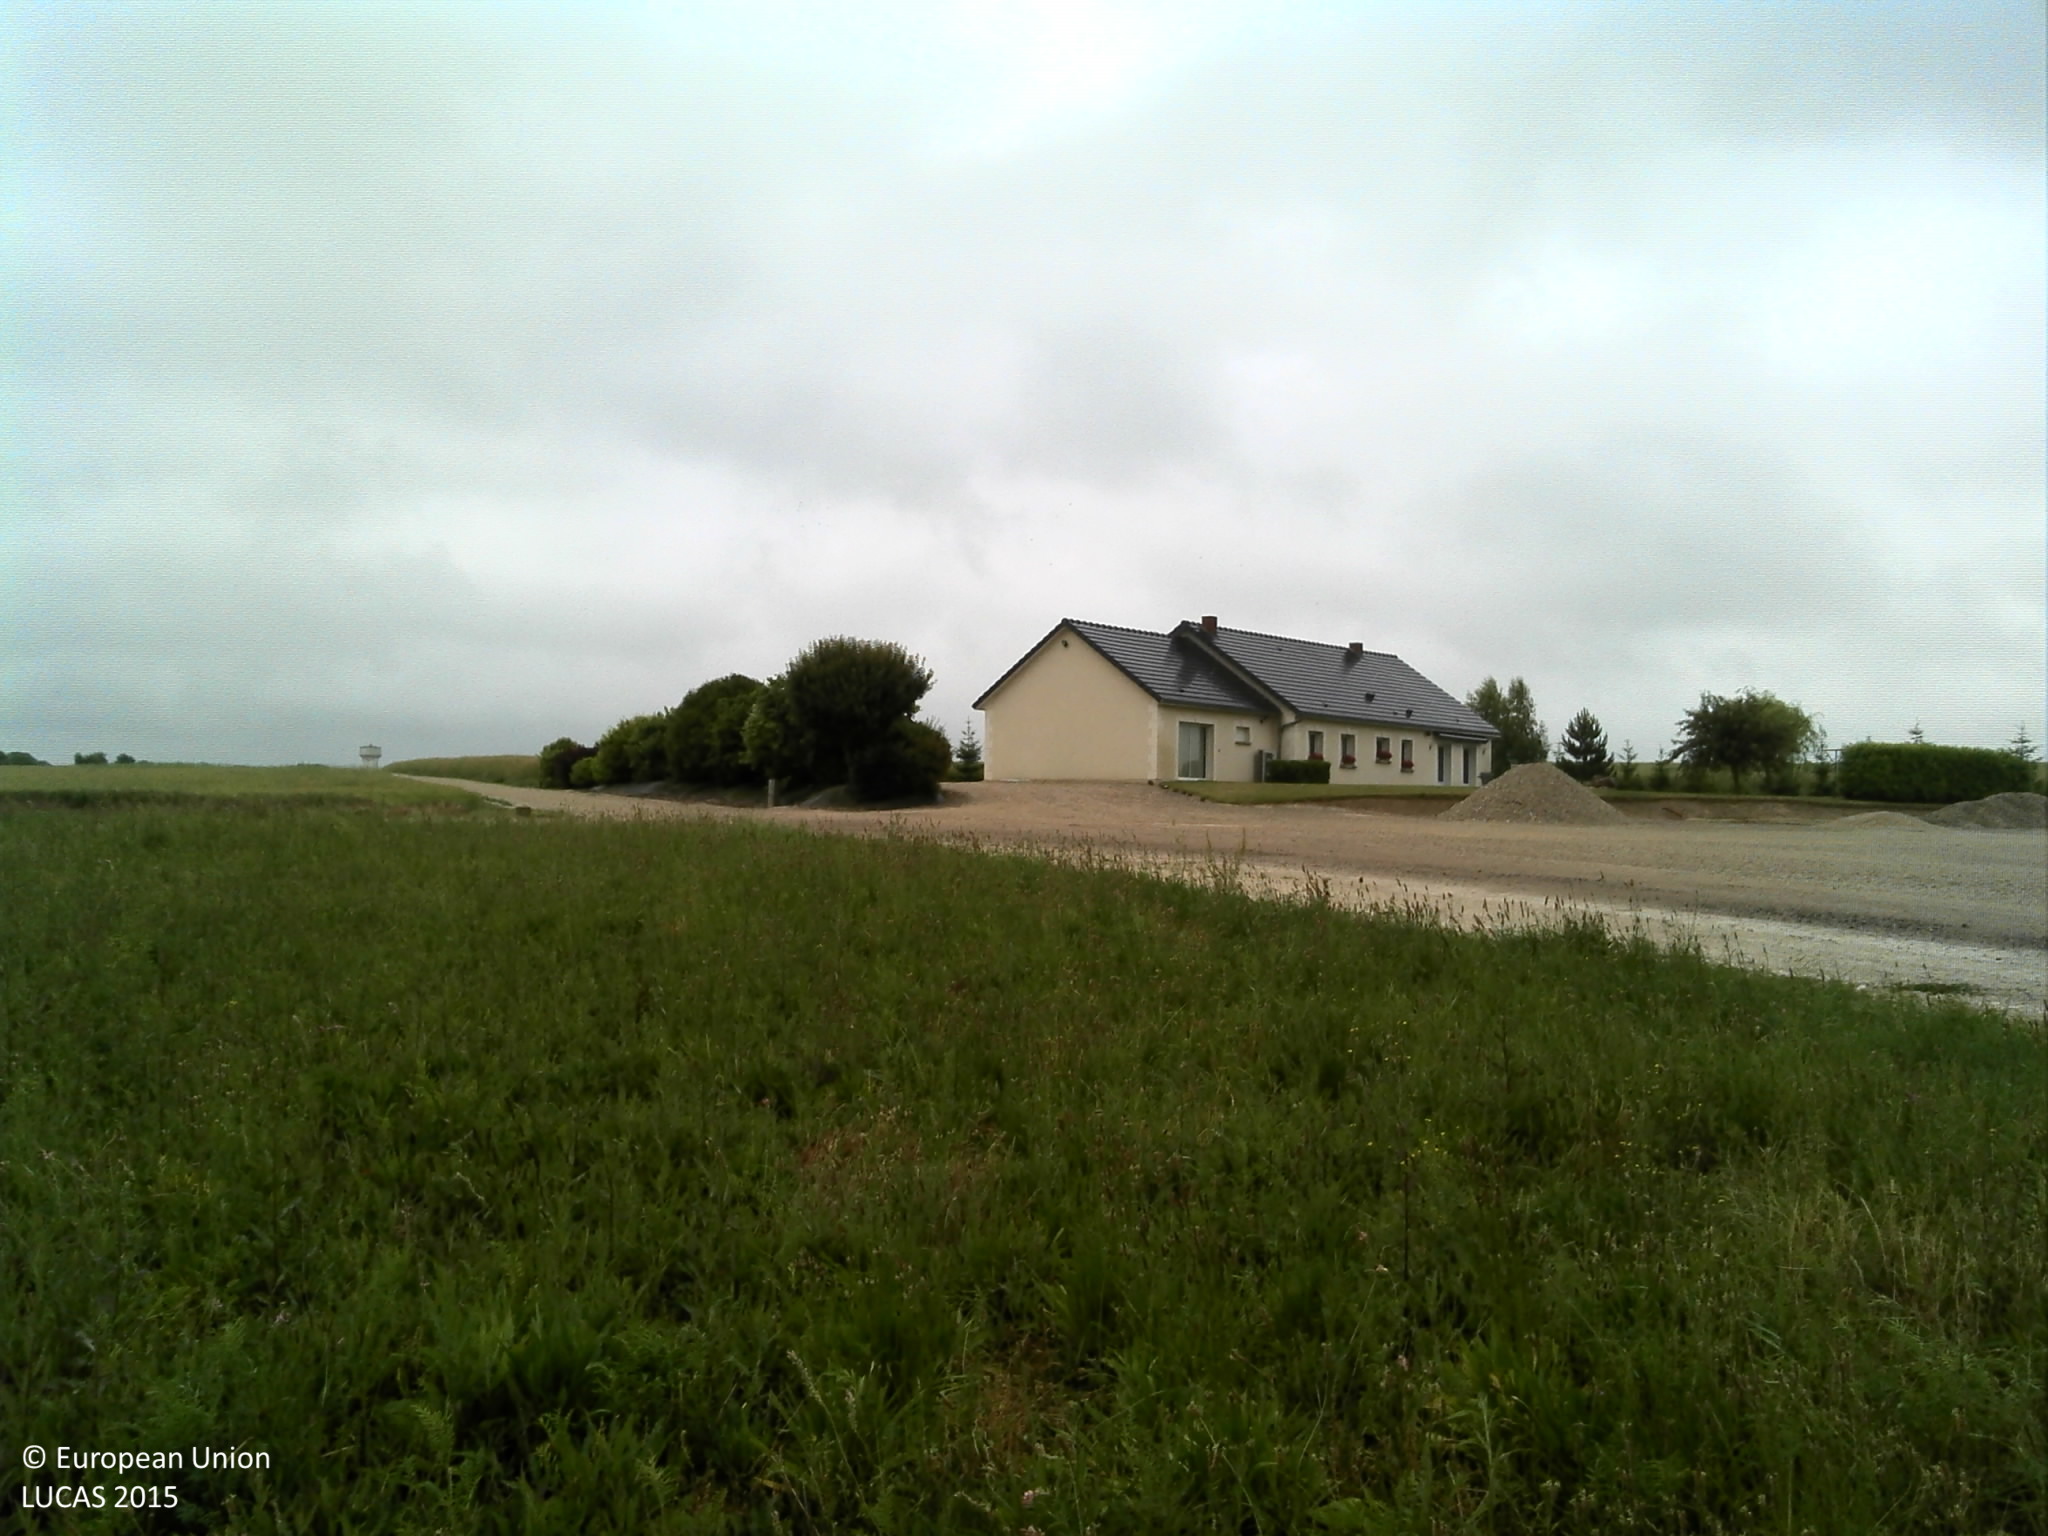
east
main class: Grassland
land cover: Spontaneously vegetated surfaces
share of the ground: > 75 %
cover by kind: herbaceous plants 80 %, lichens and mosses 10 %, consolidated bare surface 10 %
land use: Semi-natural and natural areas not in use
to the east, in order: Spontaneously vegetated surfaces; Grass margins; Tracks; Grass margins; Common wheat
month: June
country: FR
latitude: 48.6660
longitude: 4.1983
